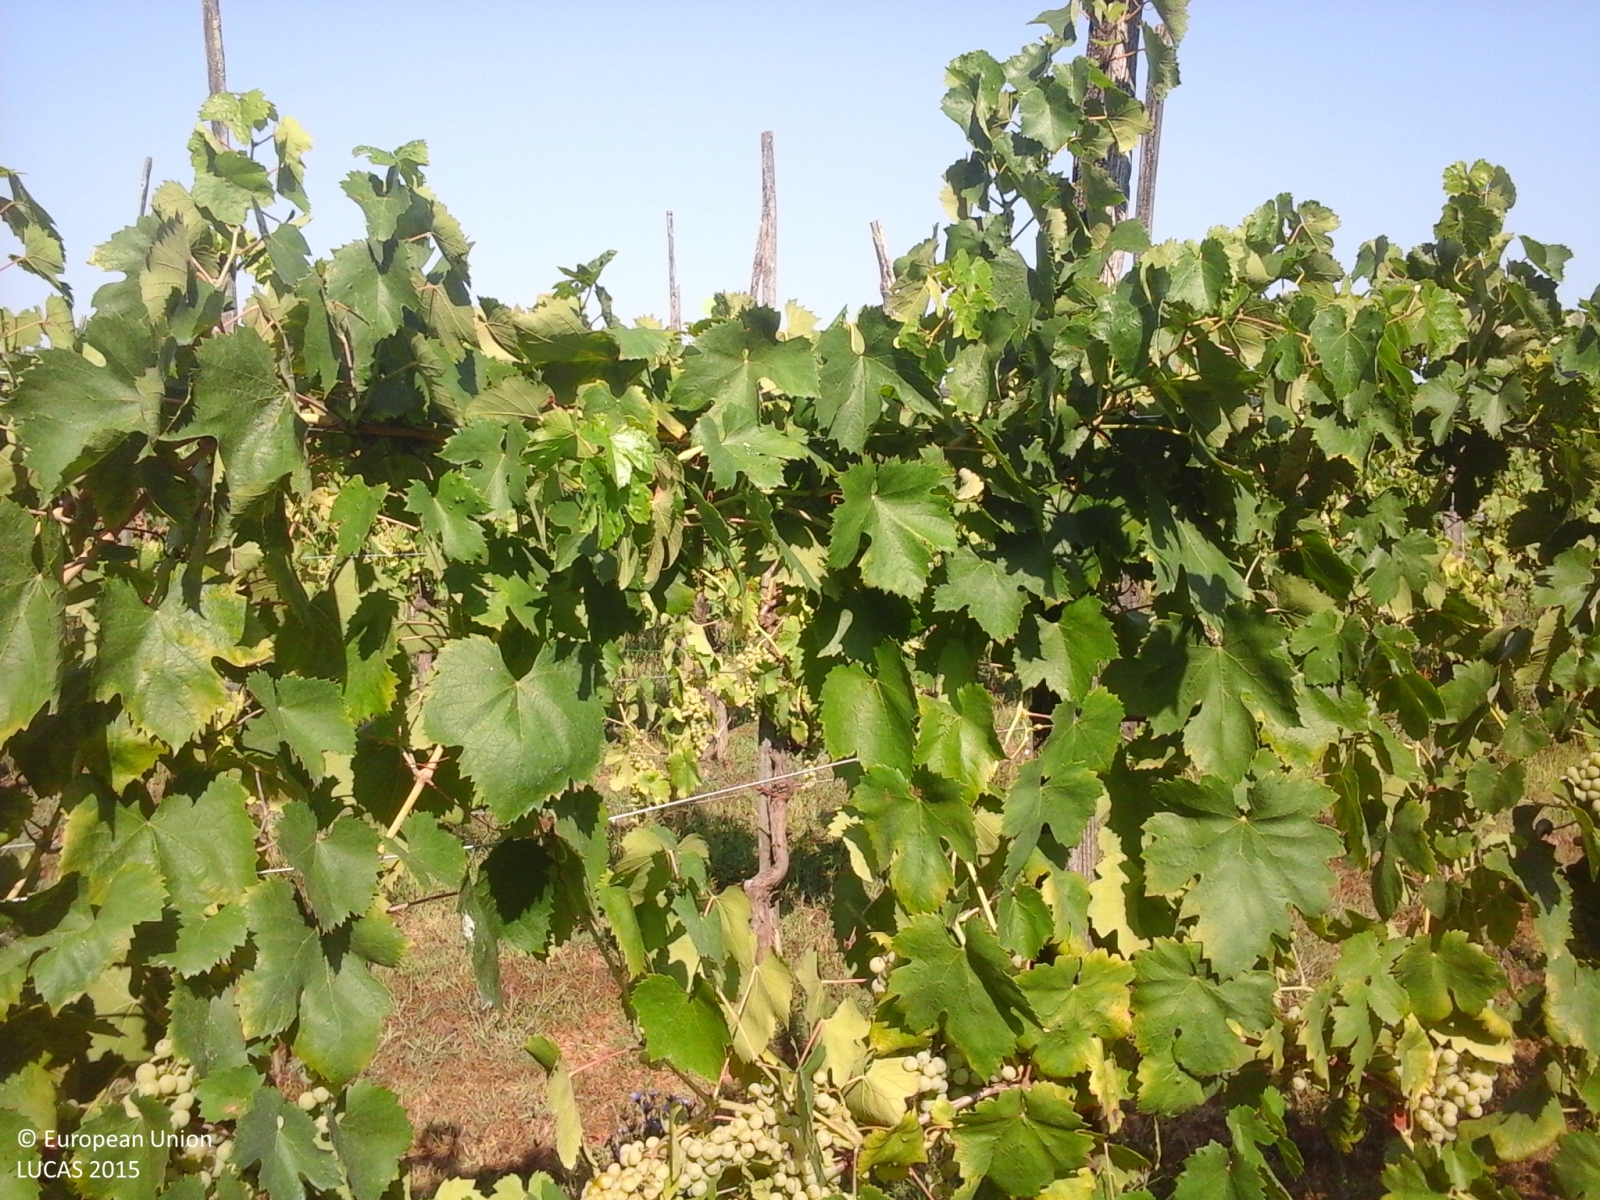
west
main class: Cropland
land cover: Vineyards
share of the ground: > 75 %
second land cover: Grassland without tree/shrub cover
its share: > 75 %
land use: Agriculture (excluding fallow land and kitchen gardens)
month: August
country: IT
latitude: 43.8435
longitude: 10.6327
